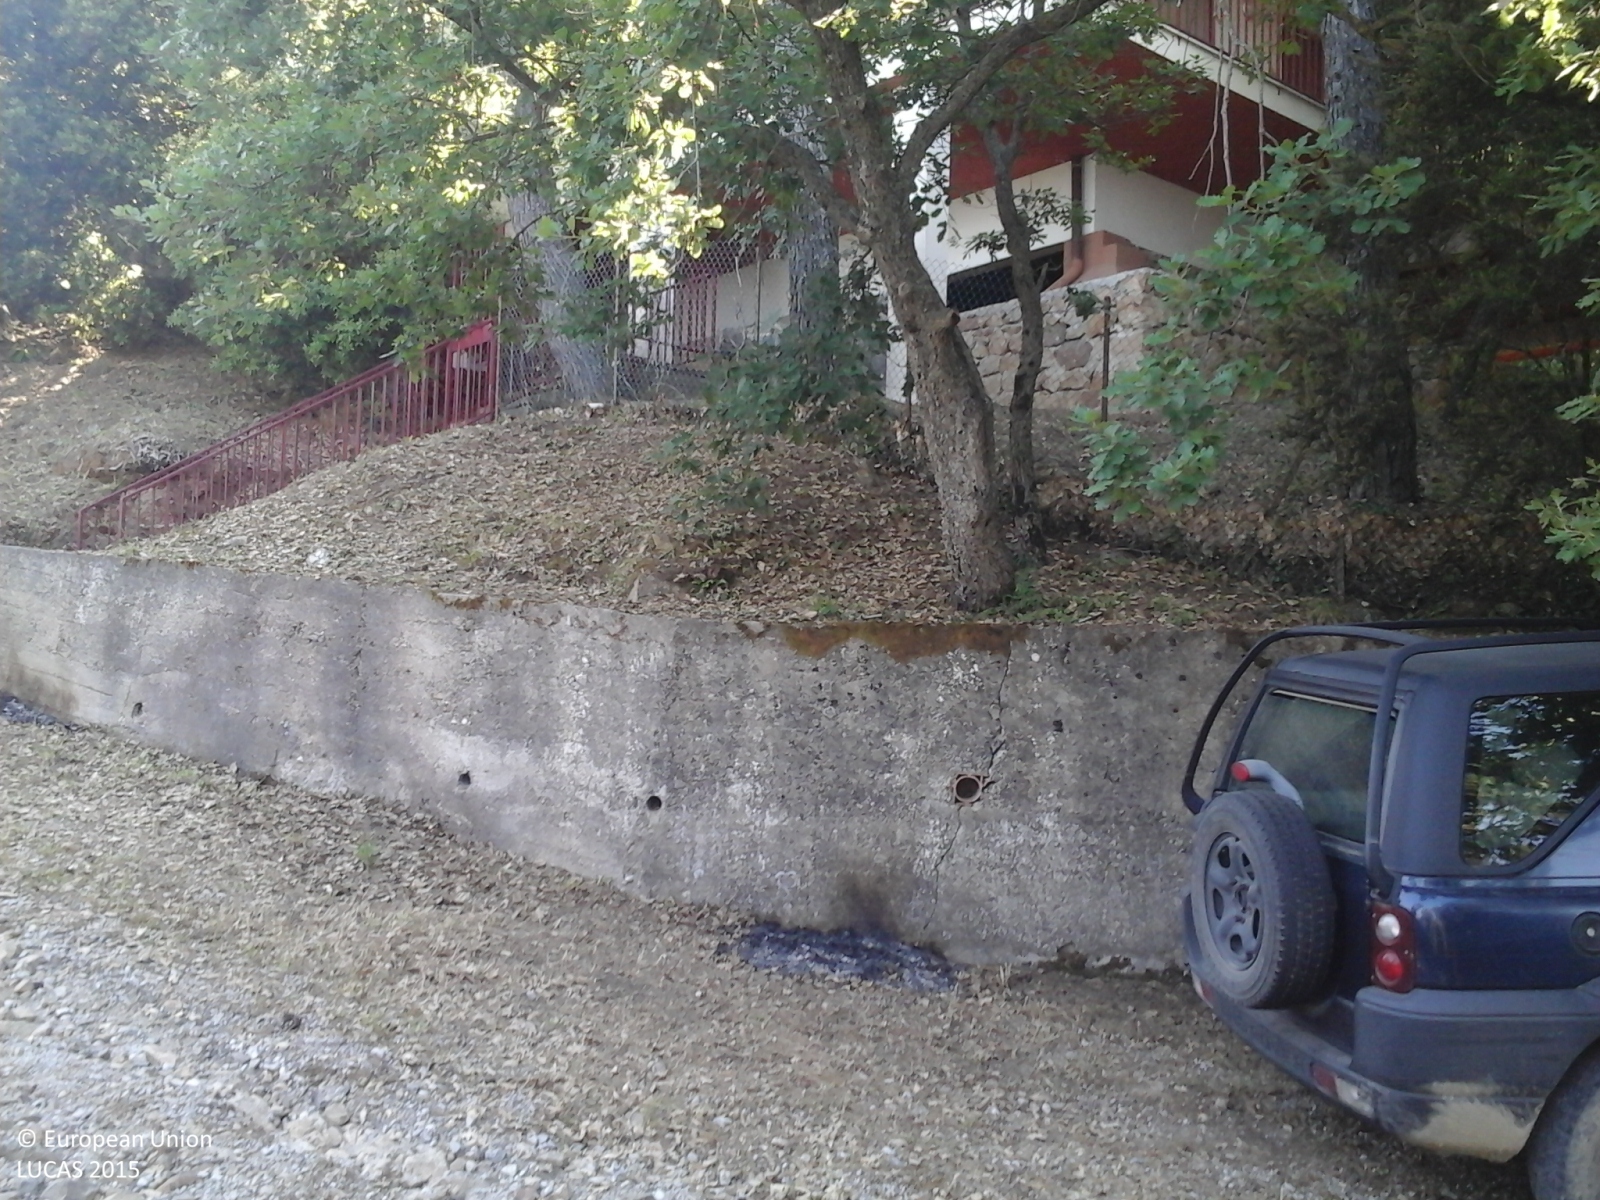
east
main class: Woodland
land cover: Broadleaved woodland
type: broadleaved evergreen forest
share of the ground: > 75 %
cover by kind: broadleaved forest trees 85 %, shrubs 10 %, herbaceous plants 5 %
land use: Forestry
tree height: > 5 m
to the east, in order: Broadleaved woodland; Artificial constructions in urban areas; Spontaneously vegetated surfaces; Fences; Broadleaved woodland
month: June
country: IT
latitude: 37.9898
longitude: 14.0142
